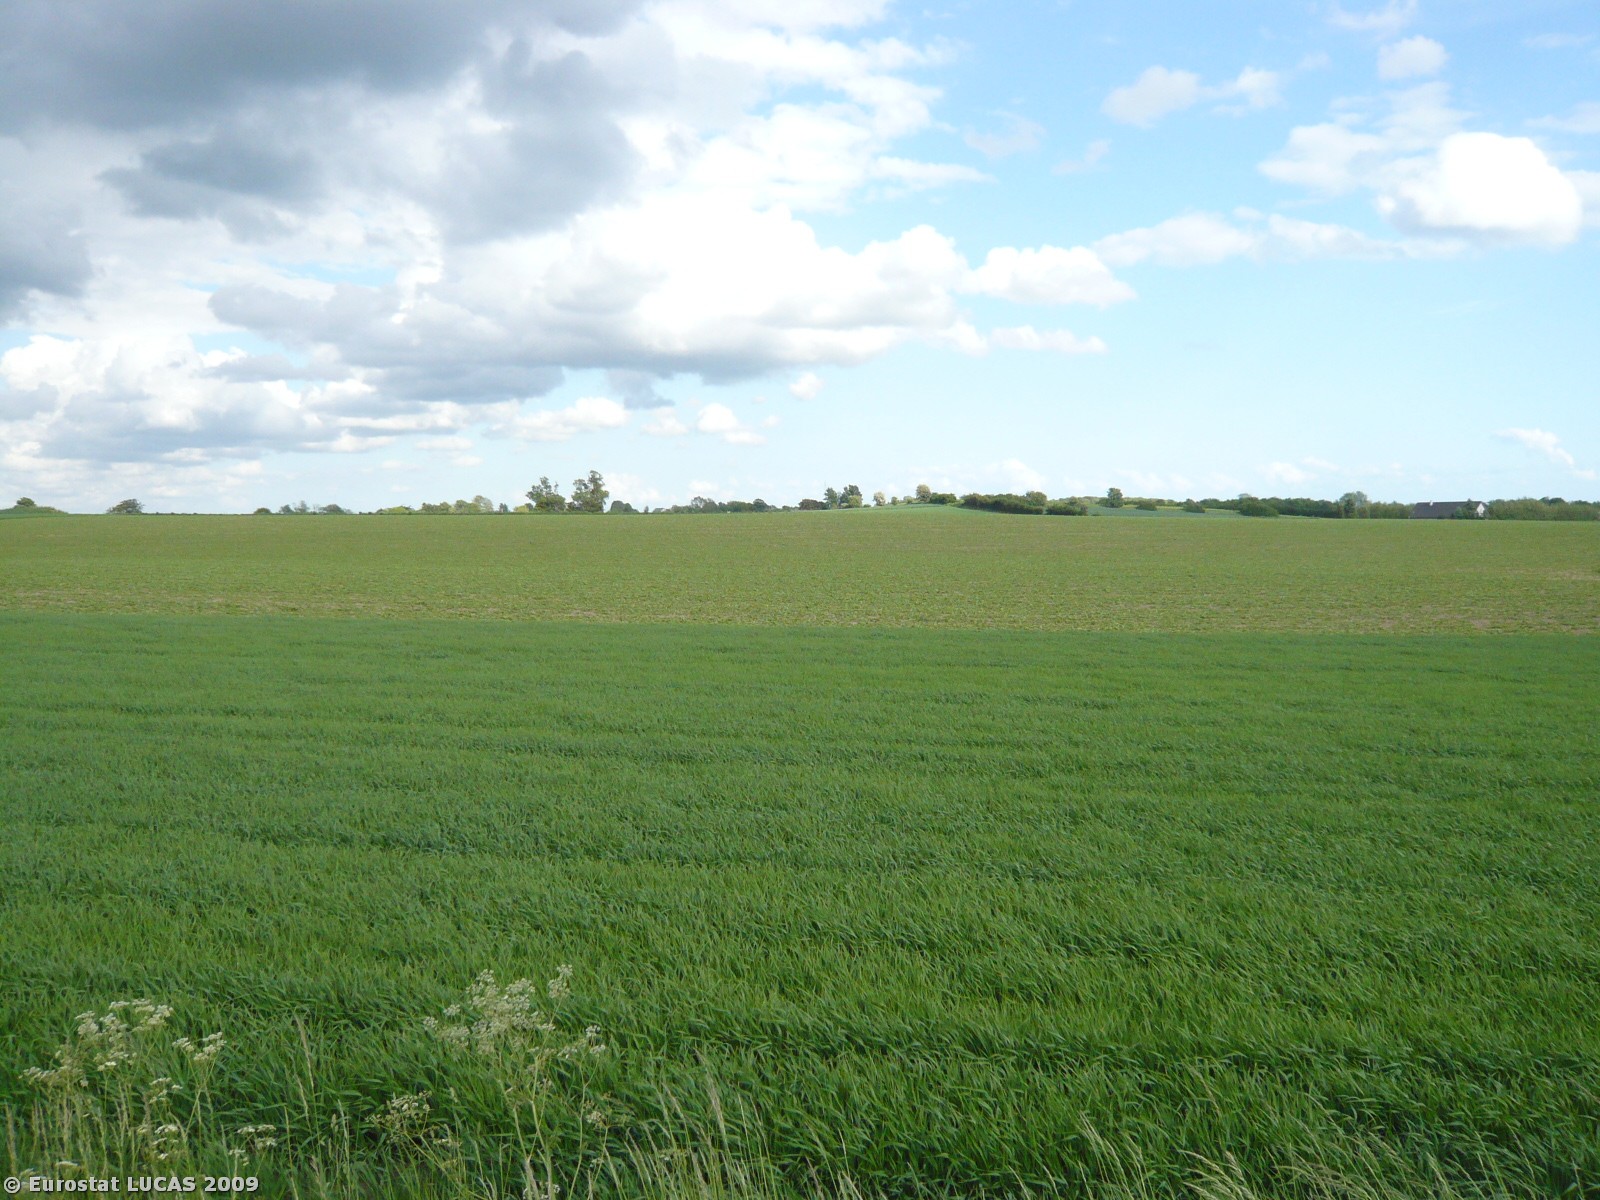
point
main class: Cropland
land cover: Sugar beet
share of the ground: 50 - 75 %
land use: Agriculture (excluding fallow land and kitchen gardens)
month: May
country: DK
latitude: 55.3161
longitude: 11.4957
